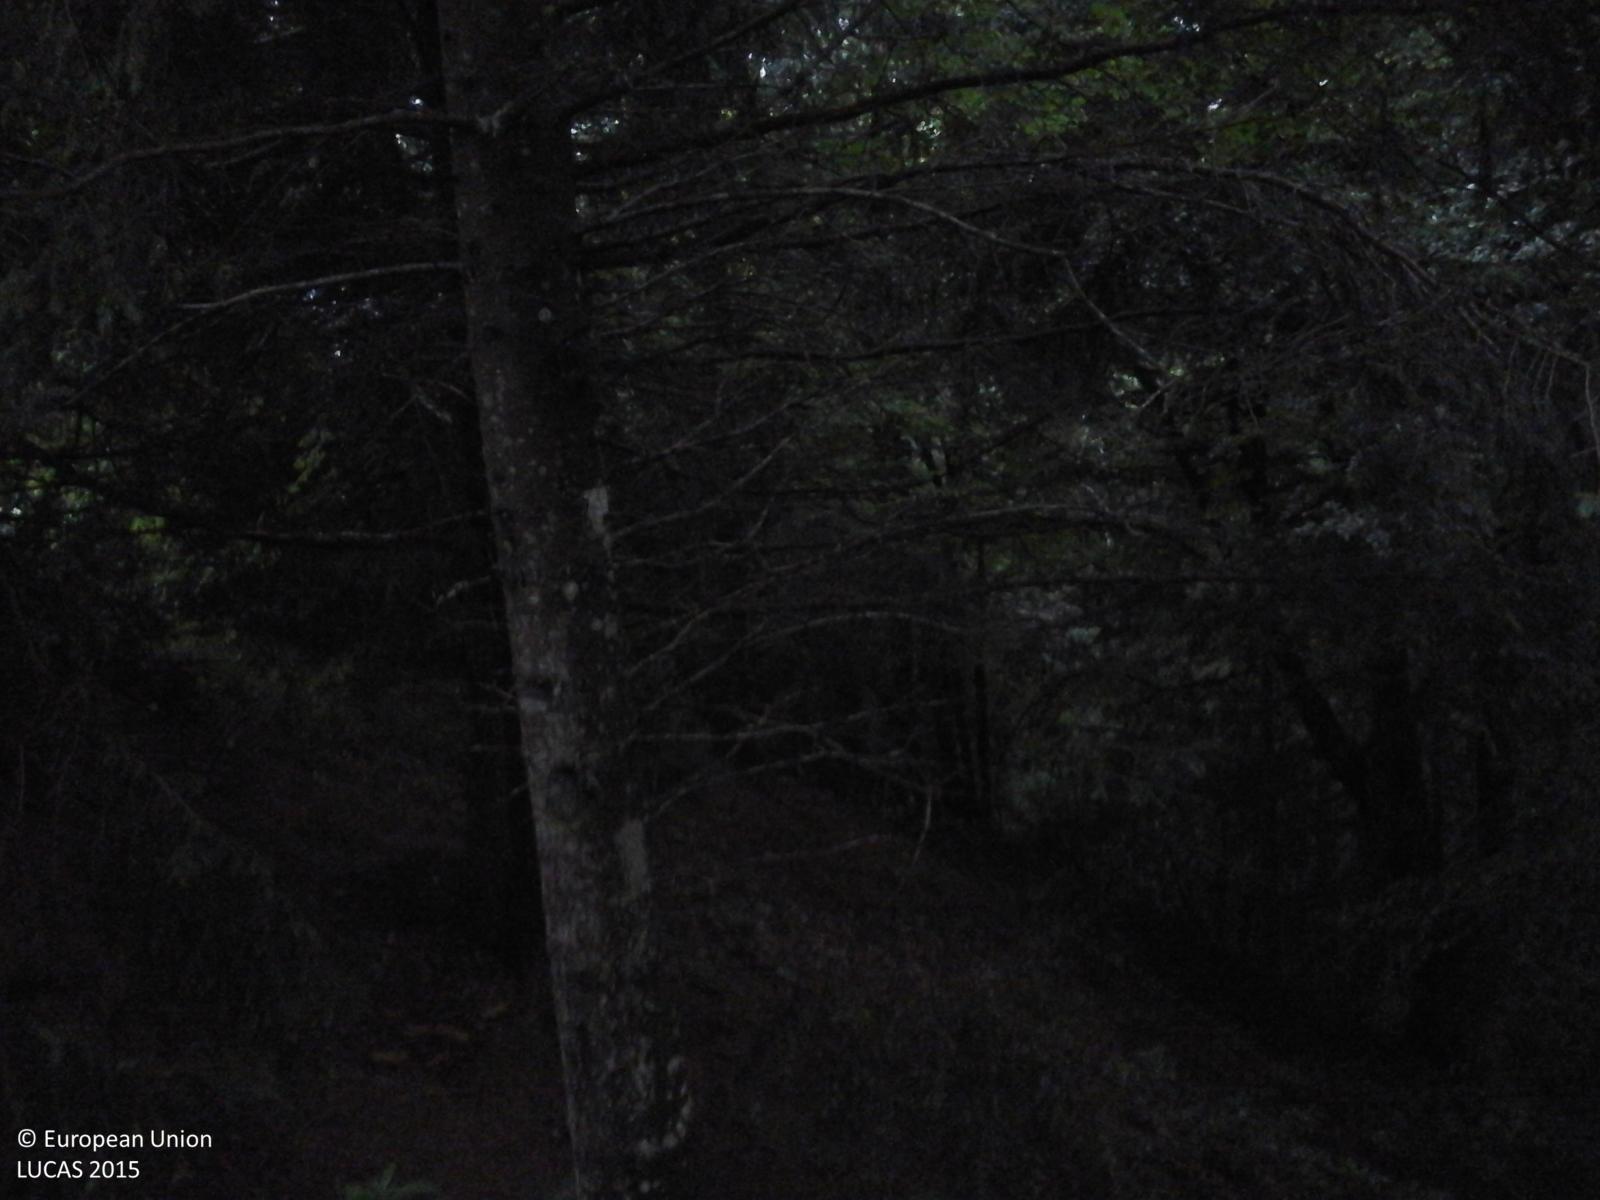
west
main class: Woodland
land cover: Spruce dominated mixed woodland
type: alpine coniferous forest
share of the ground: > 75 %
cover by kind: broadleaved forest trees 75 %, coniferous forest trees 25 %
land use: Semi-natural and natural areas not in use
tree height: > 5 m
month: July
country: IT
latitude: 45.9906
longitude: 10.2707
